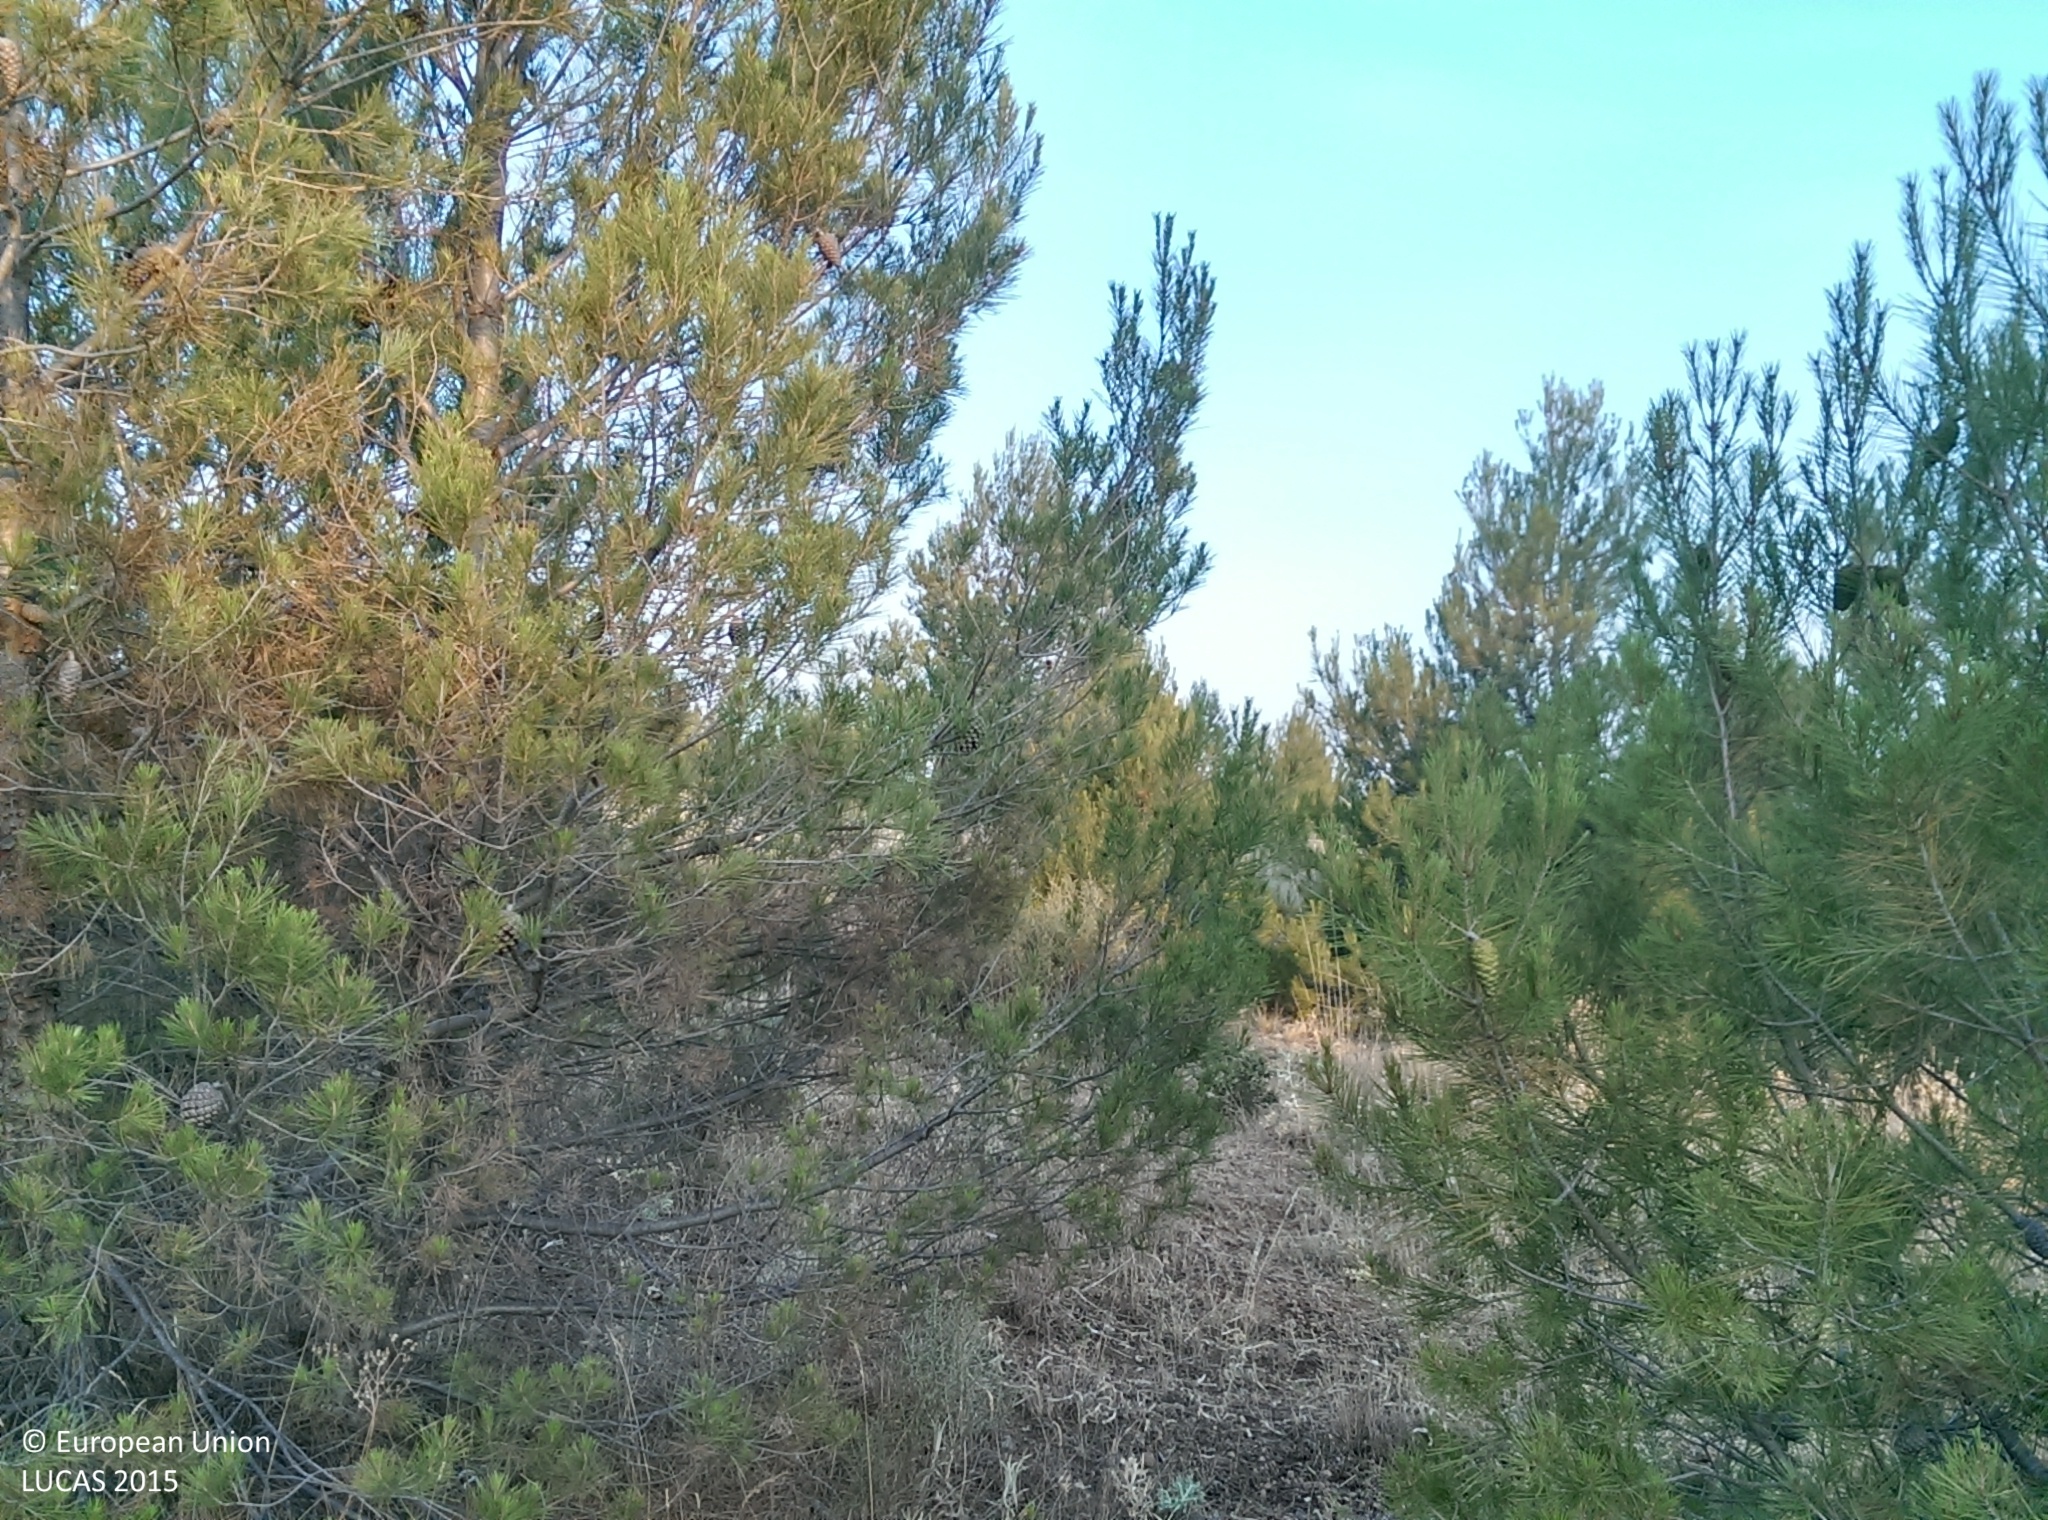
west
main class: Woodland
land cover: Pine dominated coniferous woodland
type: coniferous forest of the mediterranean region
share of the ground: 50 - 75 %
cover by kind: coniferous forest trees 55 %, shrubs 20 %, herbaceous plants 20 %, unconsolidated bare surface 5 %
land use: Forestry
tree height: < 5 m
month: July
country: ES
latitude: 37.4328
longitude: -2.9047
